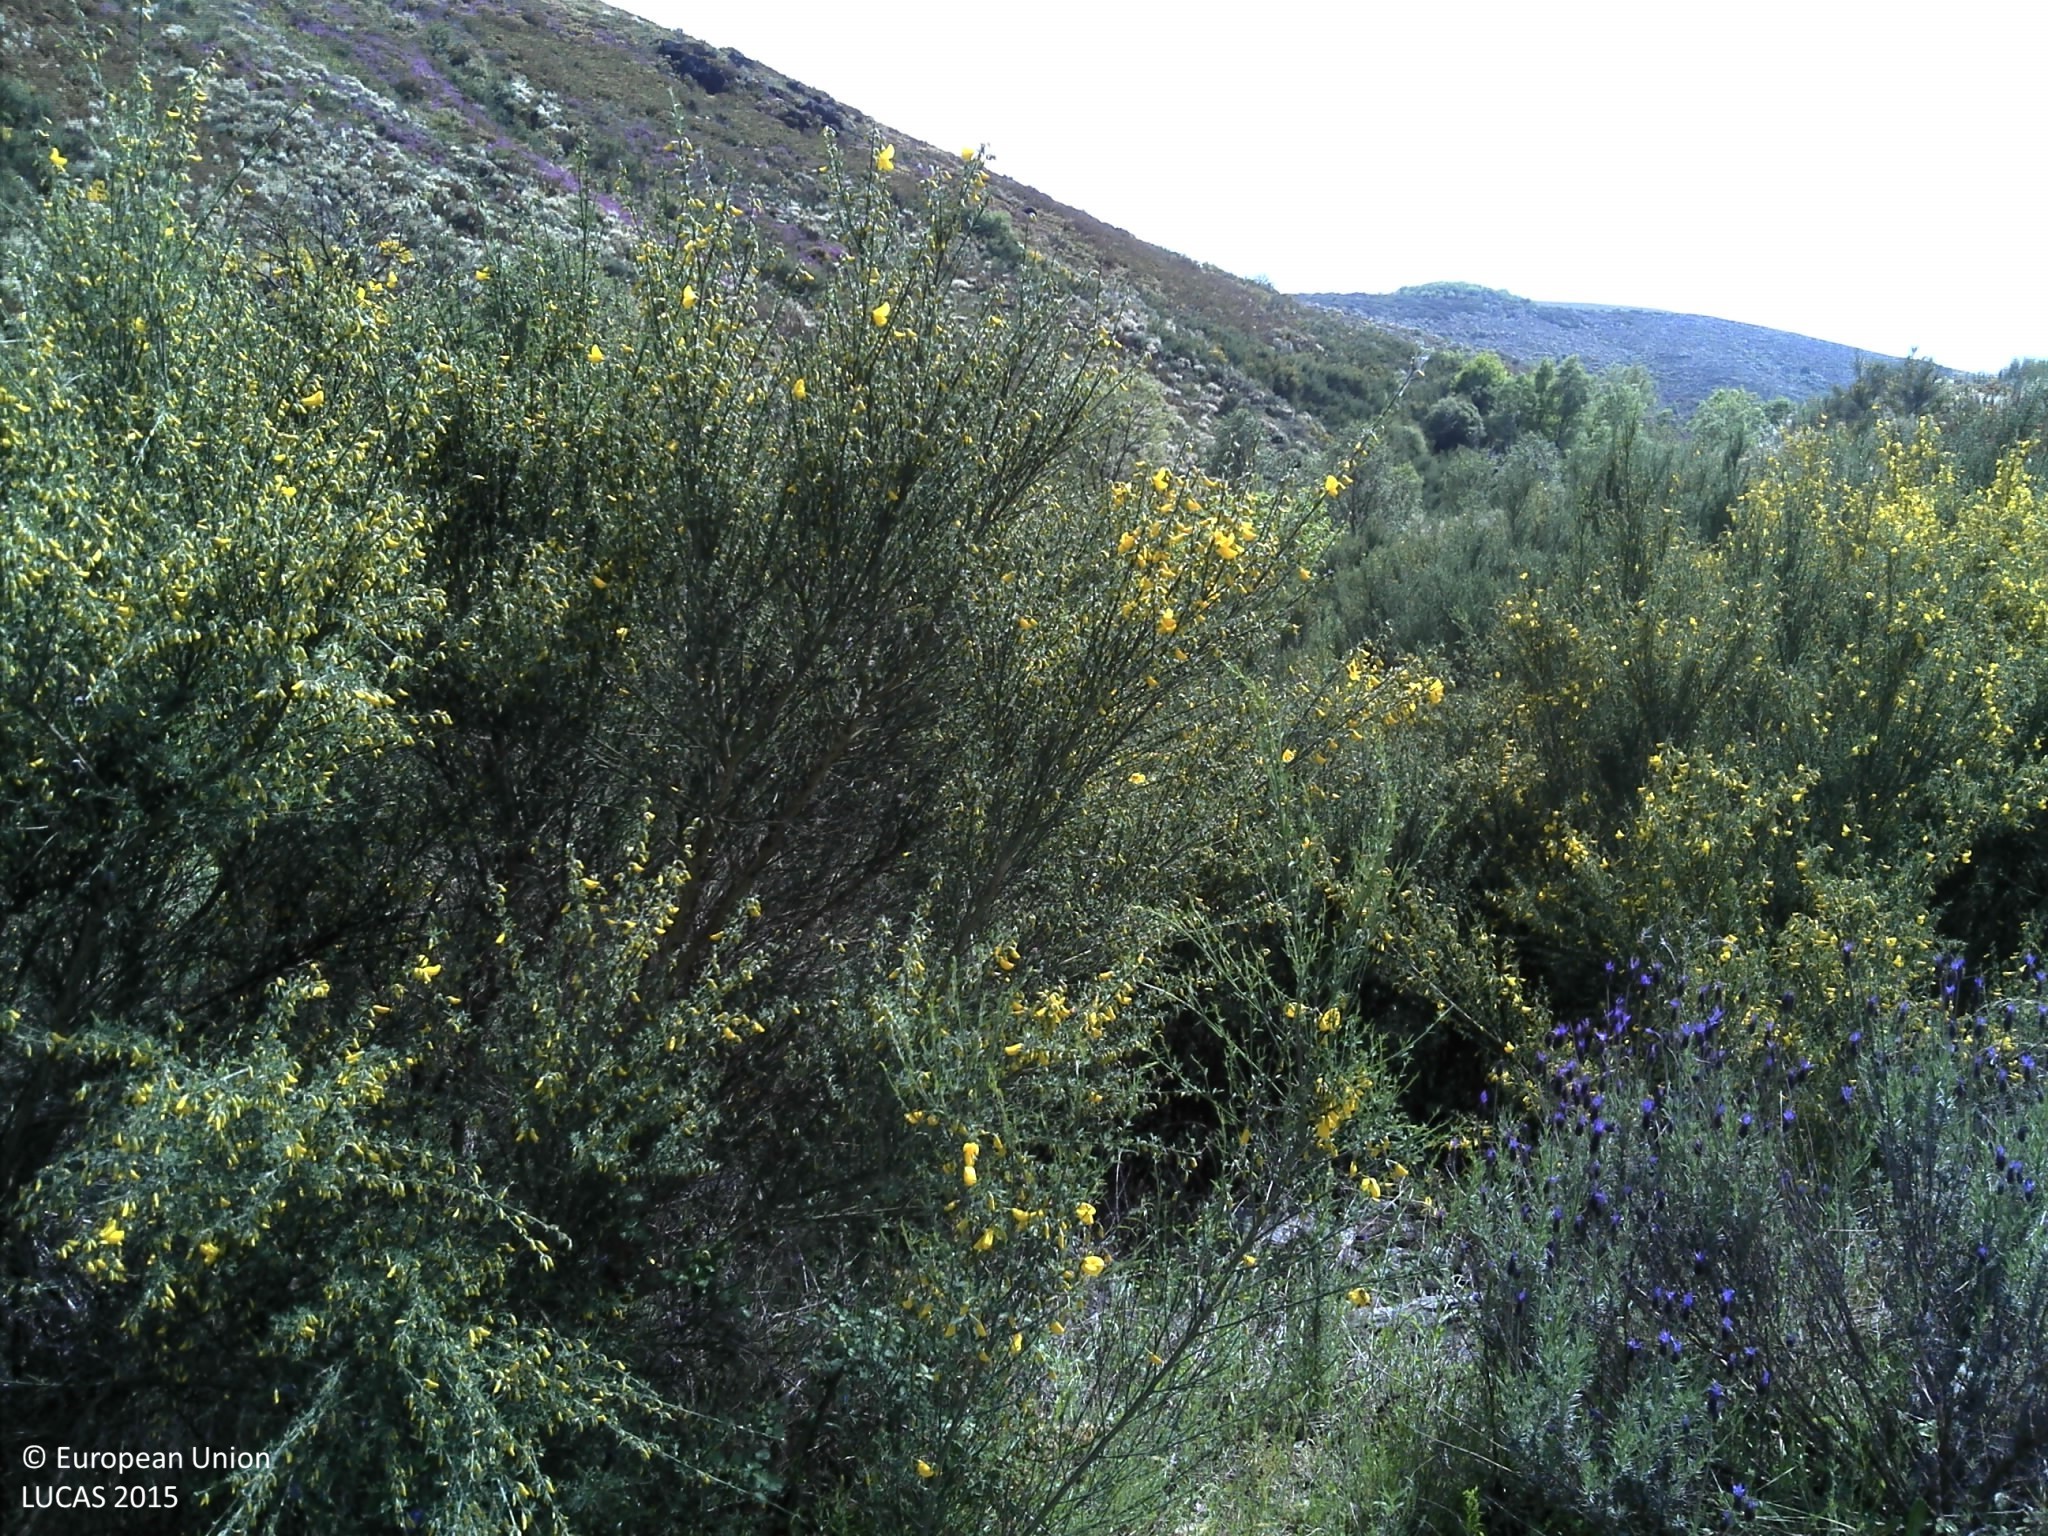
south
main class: Shrubland
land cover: Shrubland without tree cover
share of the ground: 25 - 50 %
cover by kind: shrubs 50 %, unconsolidated bare surface 40 %, herbaceous plants 10 %
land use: Semi-natural and natural areas not in use
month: May
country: PT
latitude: 41.9257
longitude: -7.0898
